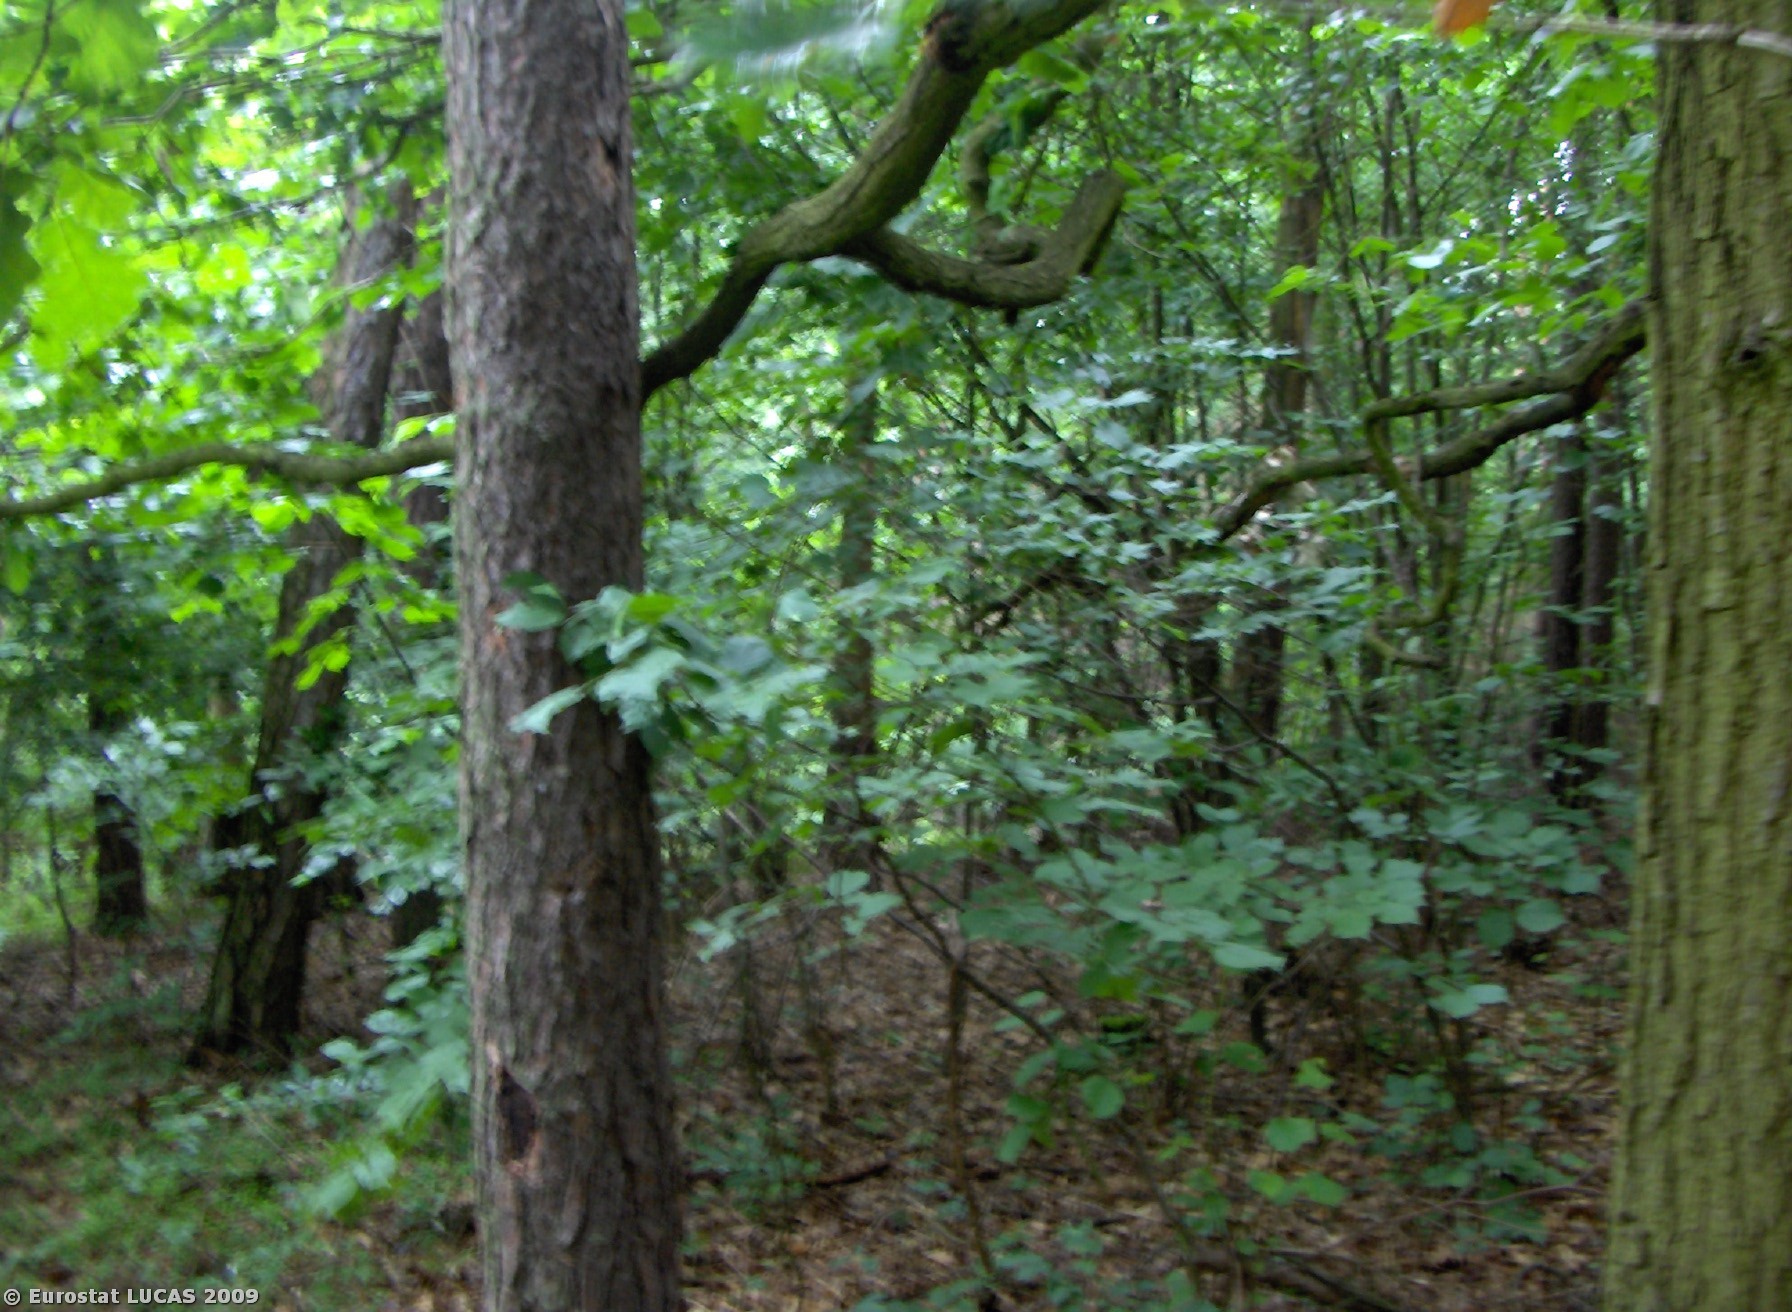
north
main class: Woodland
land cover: Mixed woodland
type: hemiboreal forest and nemoral coniferous forest and mixed broadleaved-coniferous forest
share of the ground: > 75 %
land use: Nature reserves
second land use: Forestry
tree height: > 5 m
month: June
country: CZ
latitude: 49.7223
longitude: 14.3707
